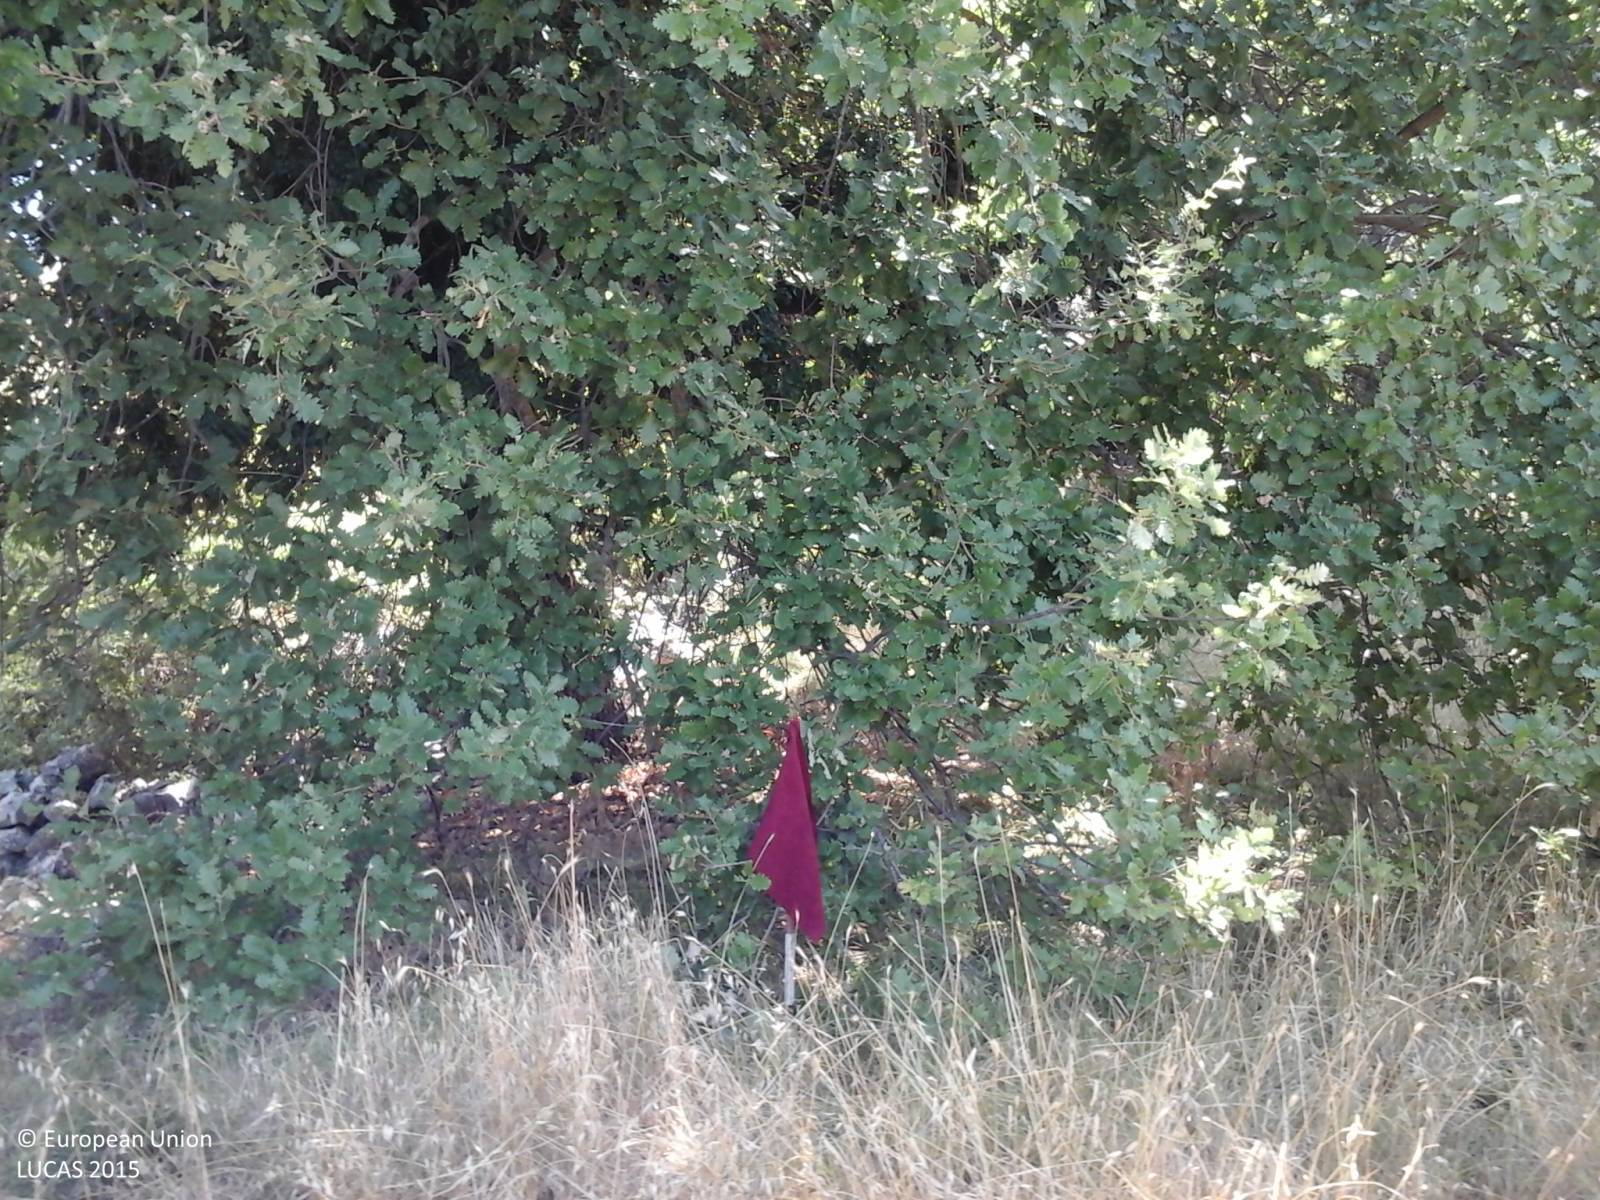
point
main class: Woodland
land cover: Broadleaved woodland
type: thermophilous deciduous forest
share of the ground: 25 - 50 %
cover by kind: broadleaved forest trees 90 %, herbaceous plants 10 %
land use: Semi-natural and natural areas not in use
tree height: > 5 m
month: July
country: IT
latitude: 40.7850
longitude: 8.8088
